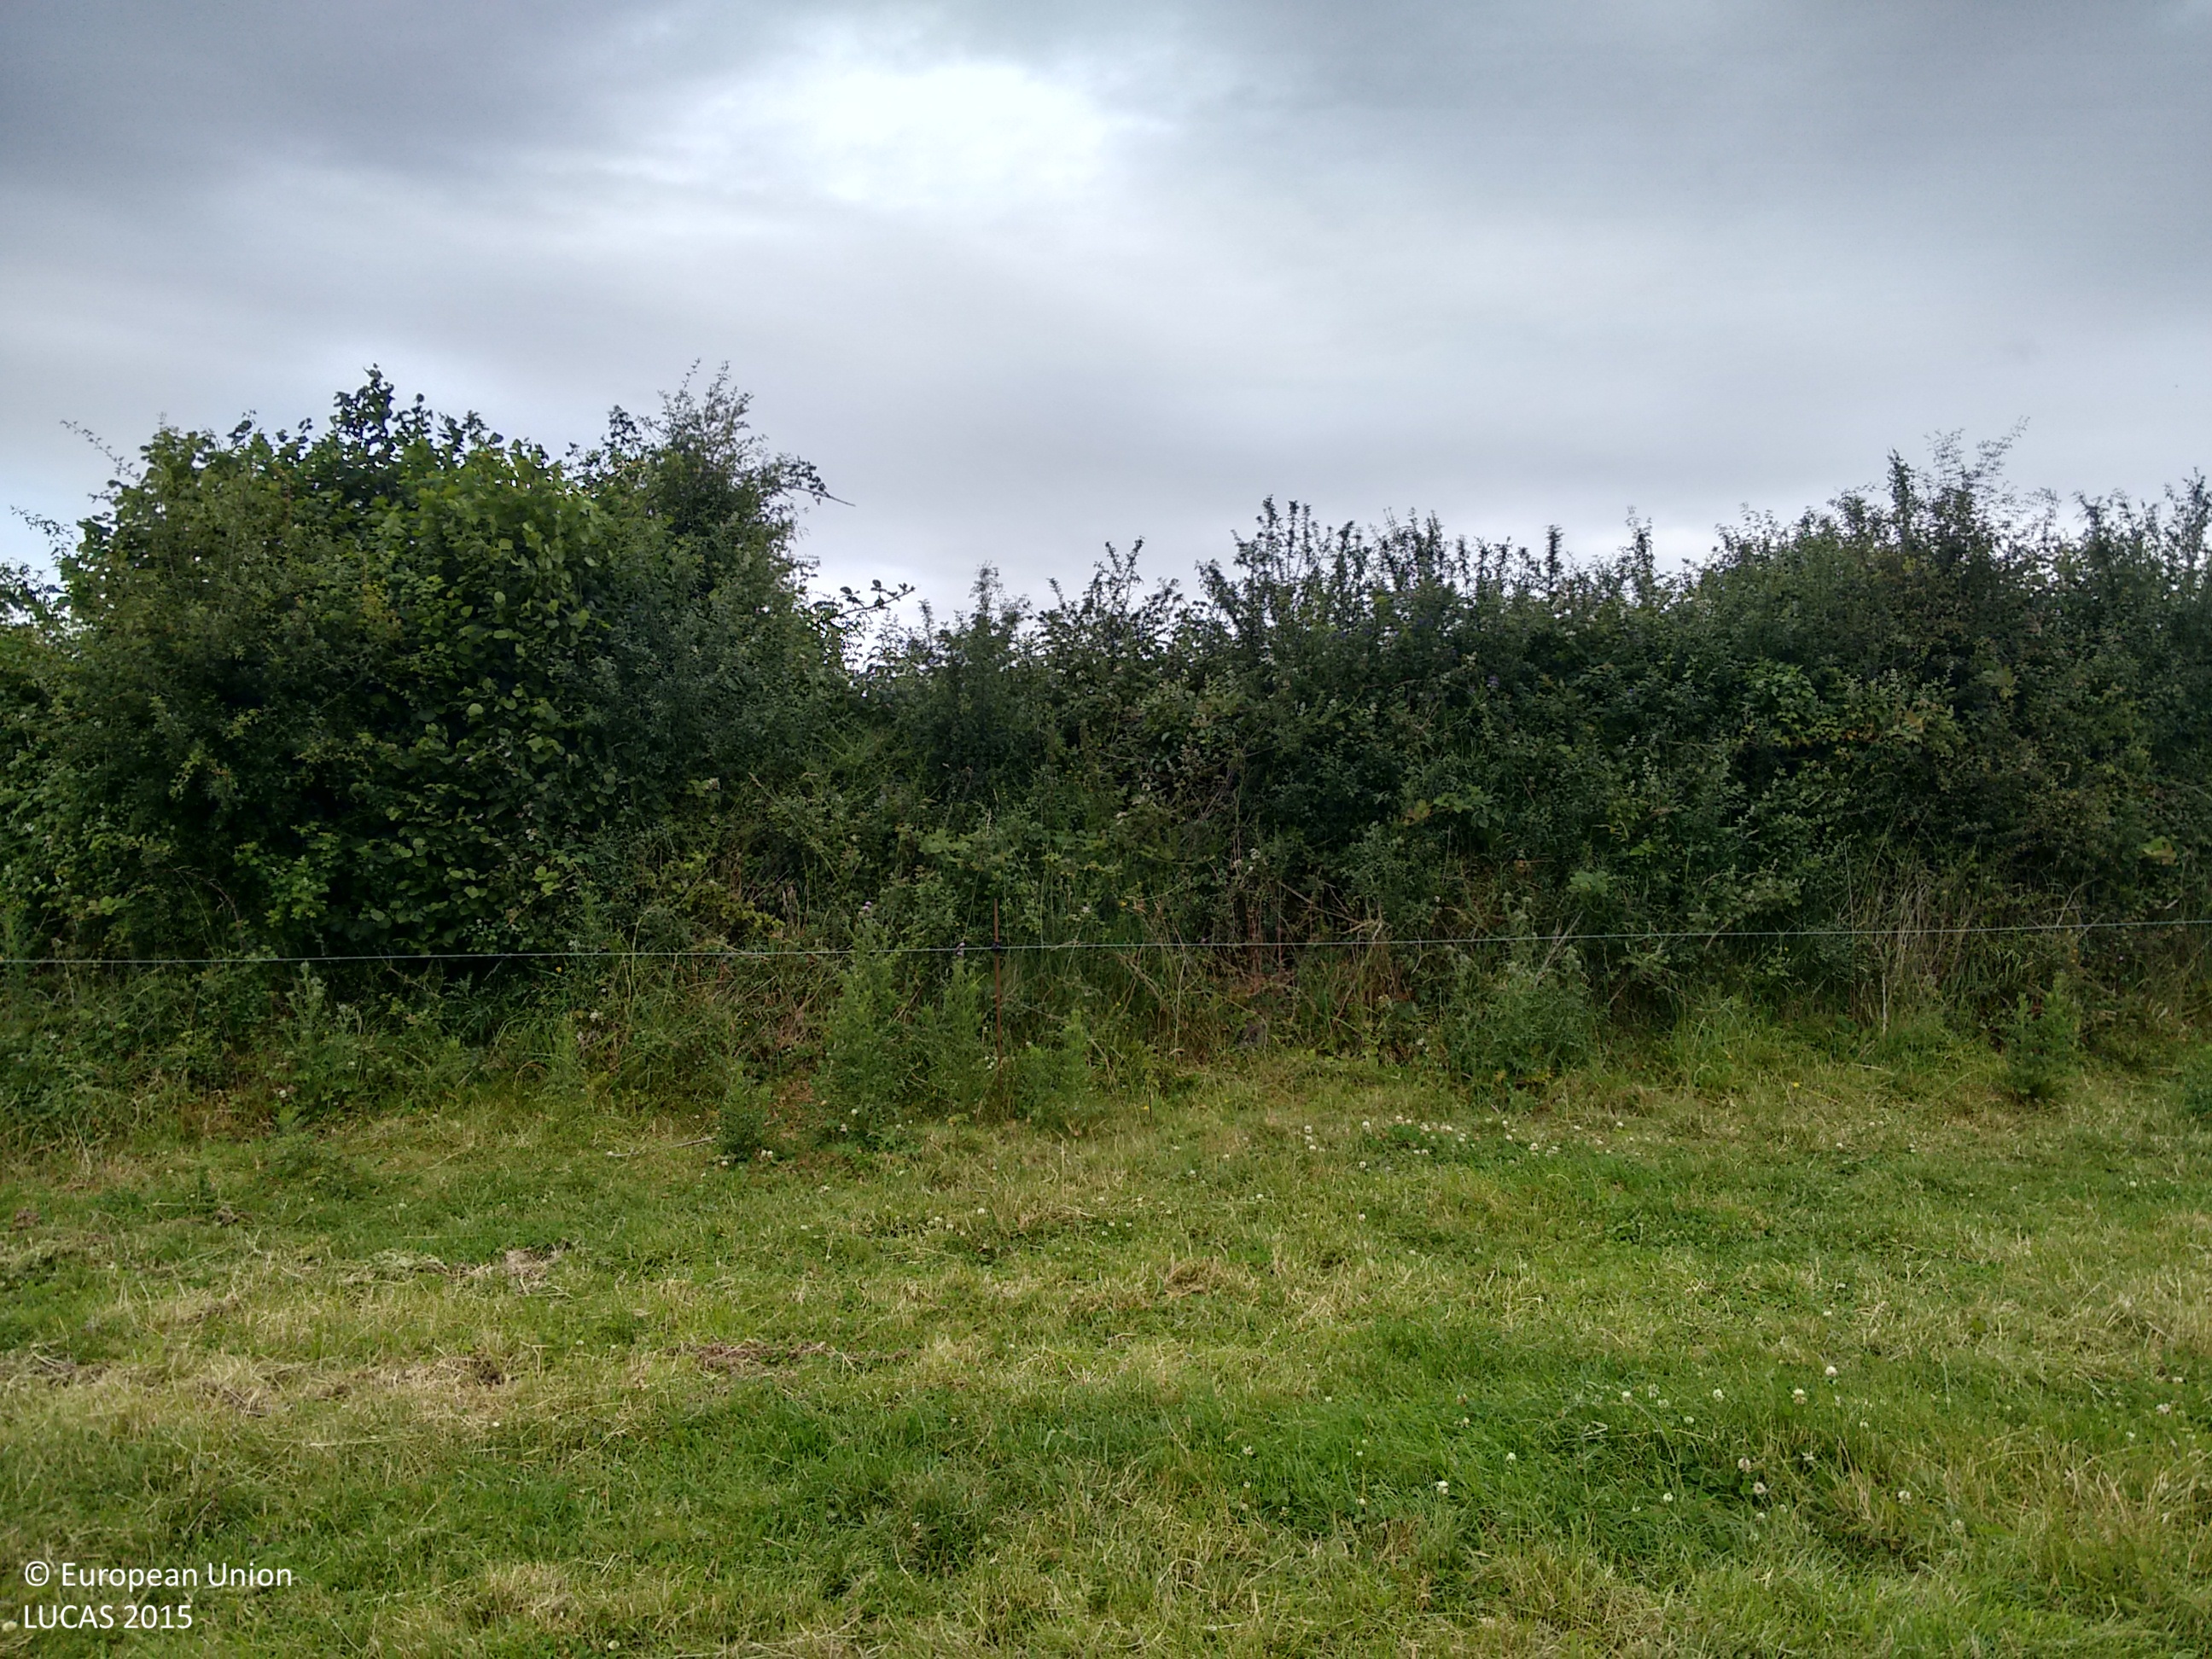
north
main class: Grassland
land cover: Grassland without tree/shrub cover
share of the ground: > 75 %
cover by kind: herbaceous plants 100 %
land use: Agriculture (excluding fallow land and kitchen gardens)
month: July
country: IE
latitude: 53.6234
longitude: -8.0008
